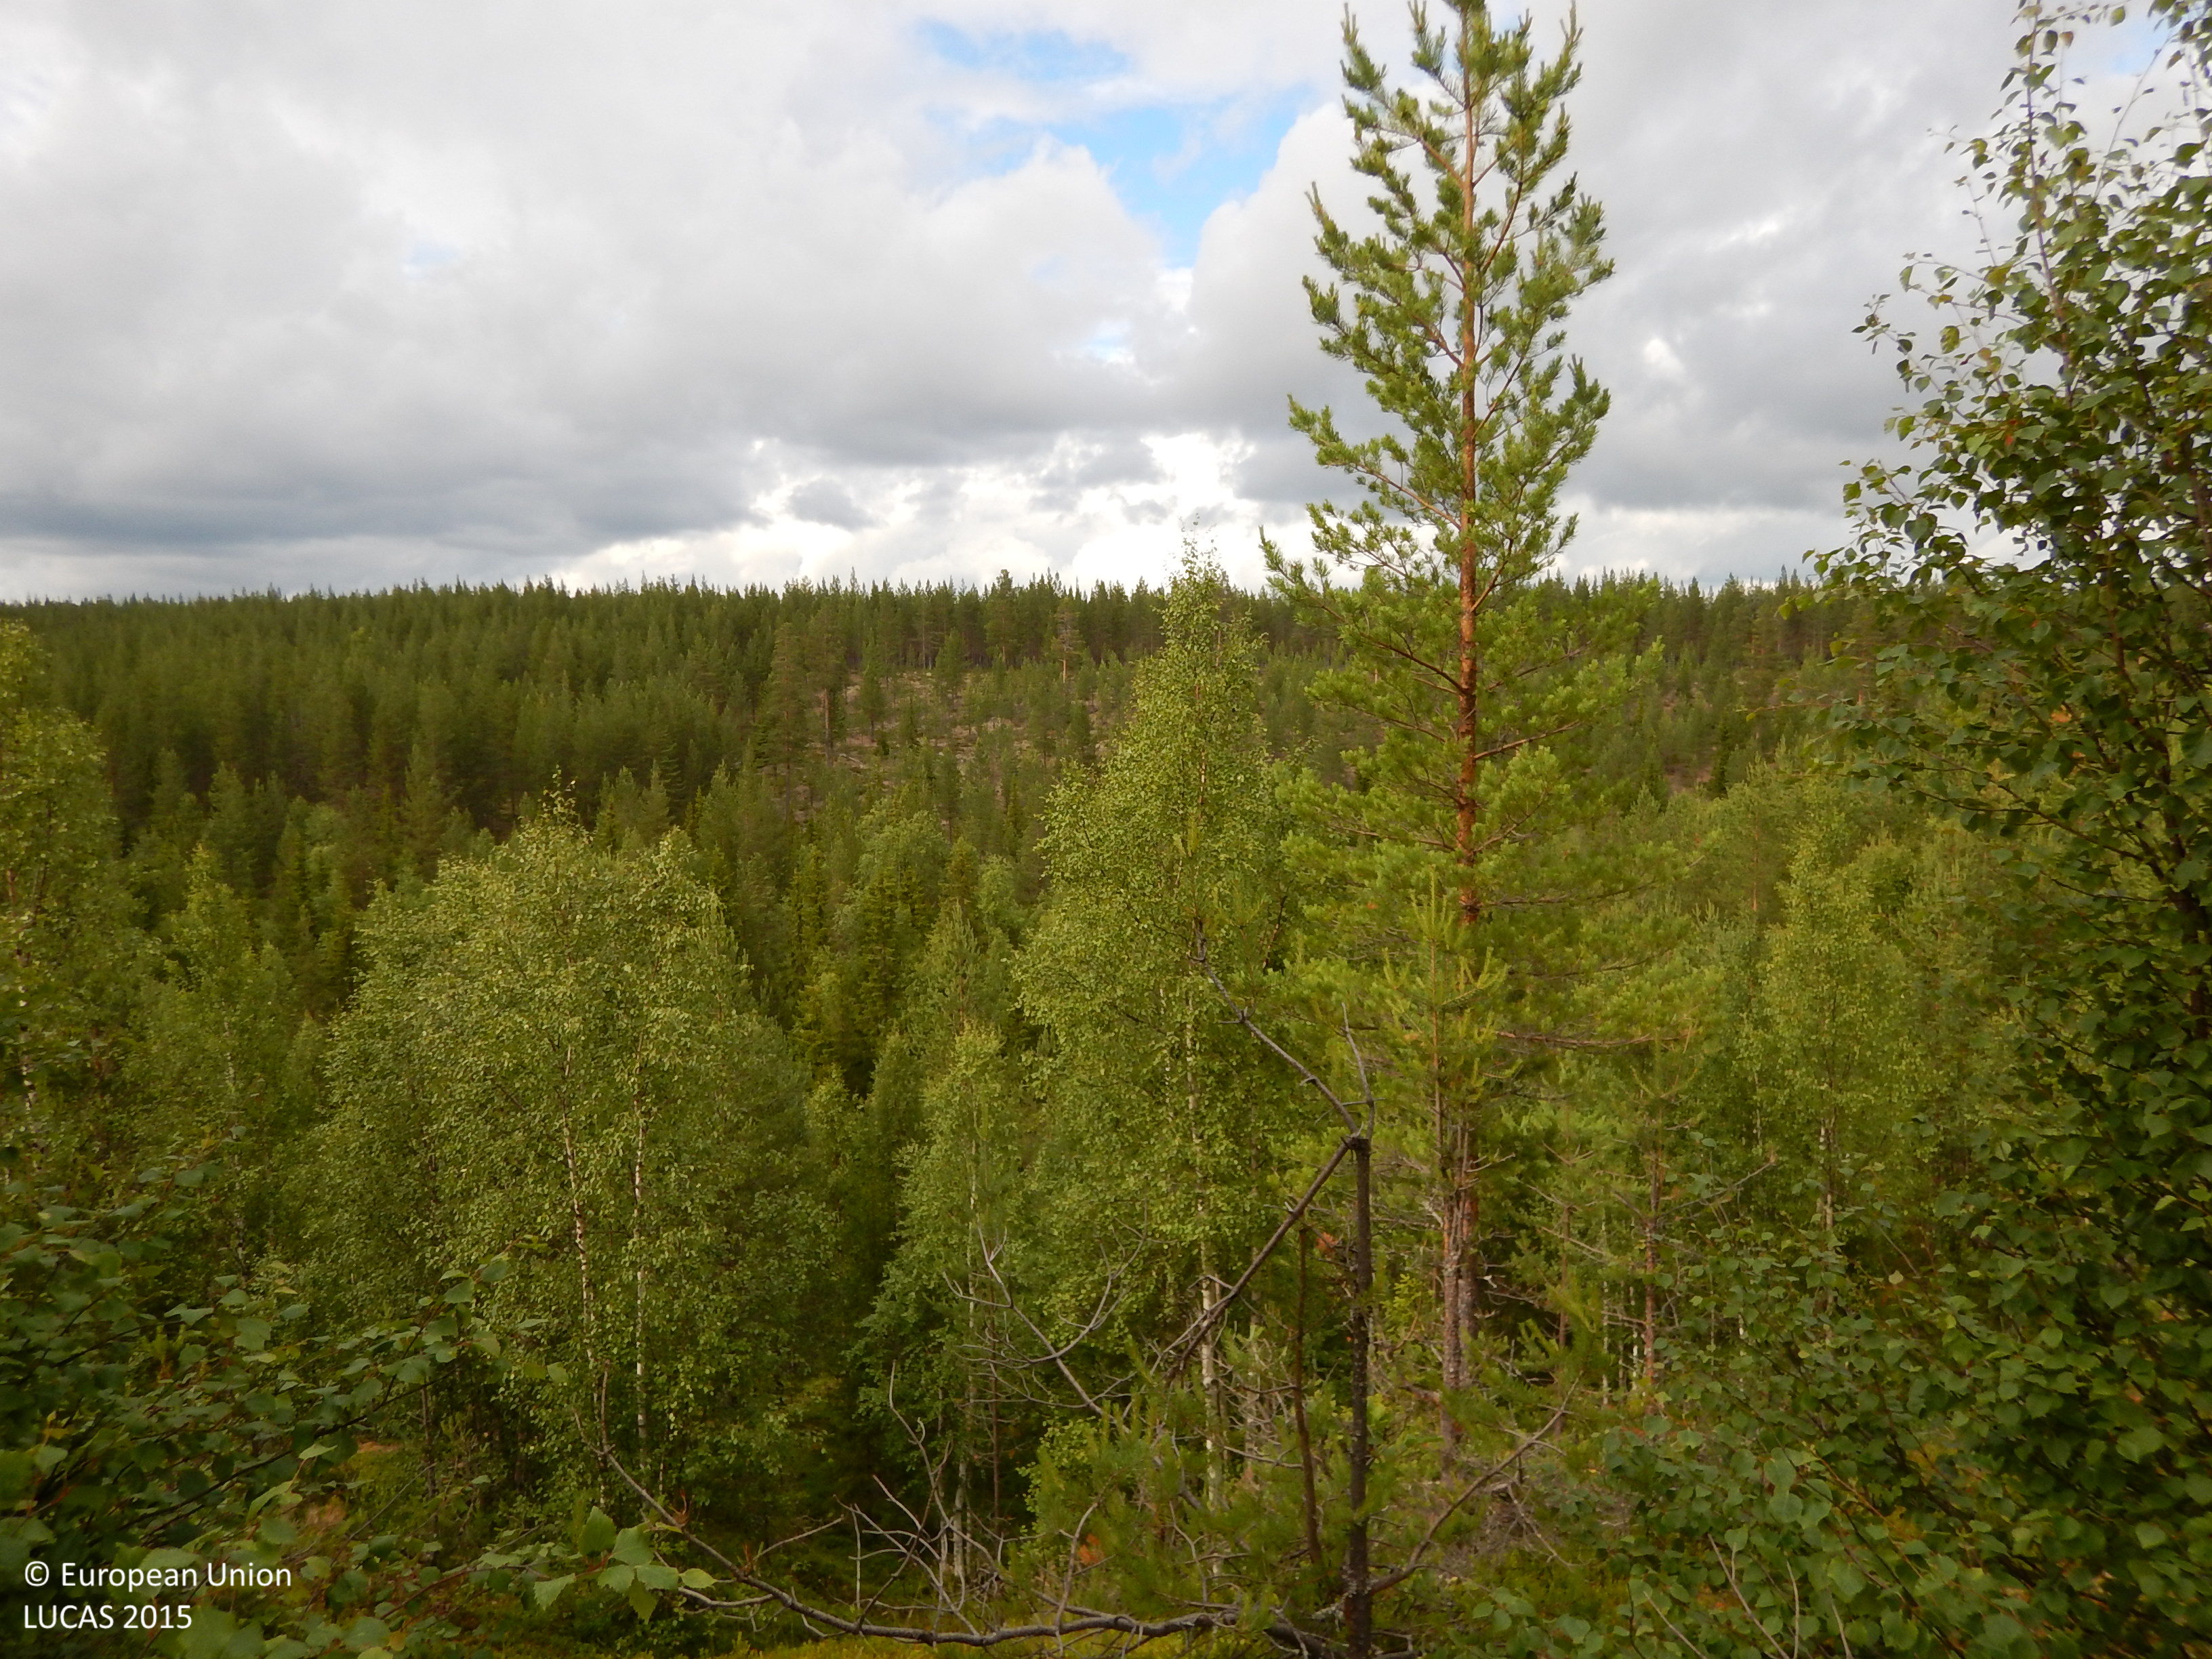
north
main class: Woodland
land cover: Pine dominated mixed woodland
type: boreal forest
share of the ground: 50 - 75 %
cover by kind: coniferous forest trees 35 %, shrubs 20 %, broadleaved forest trees 15 %, herbaceous plants 15 %, lichens and mosses 15 %
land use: Forestry
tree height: < 5 m
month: July
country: SE
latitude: 64.6645
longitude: 20.2999
